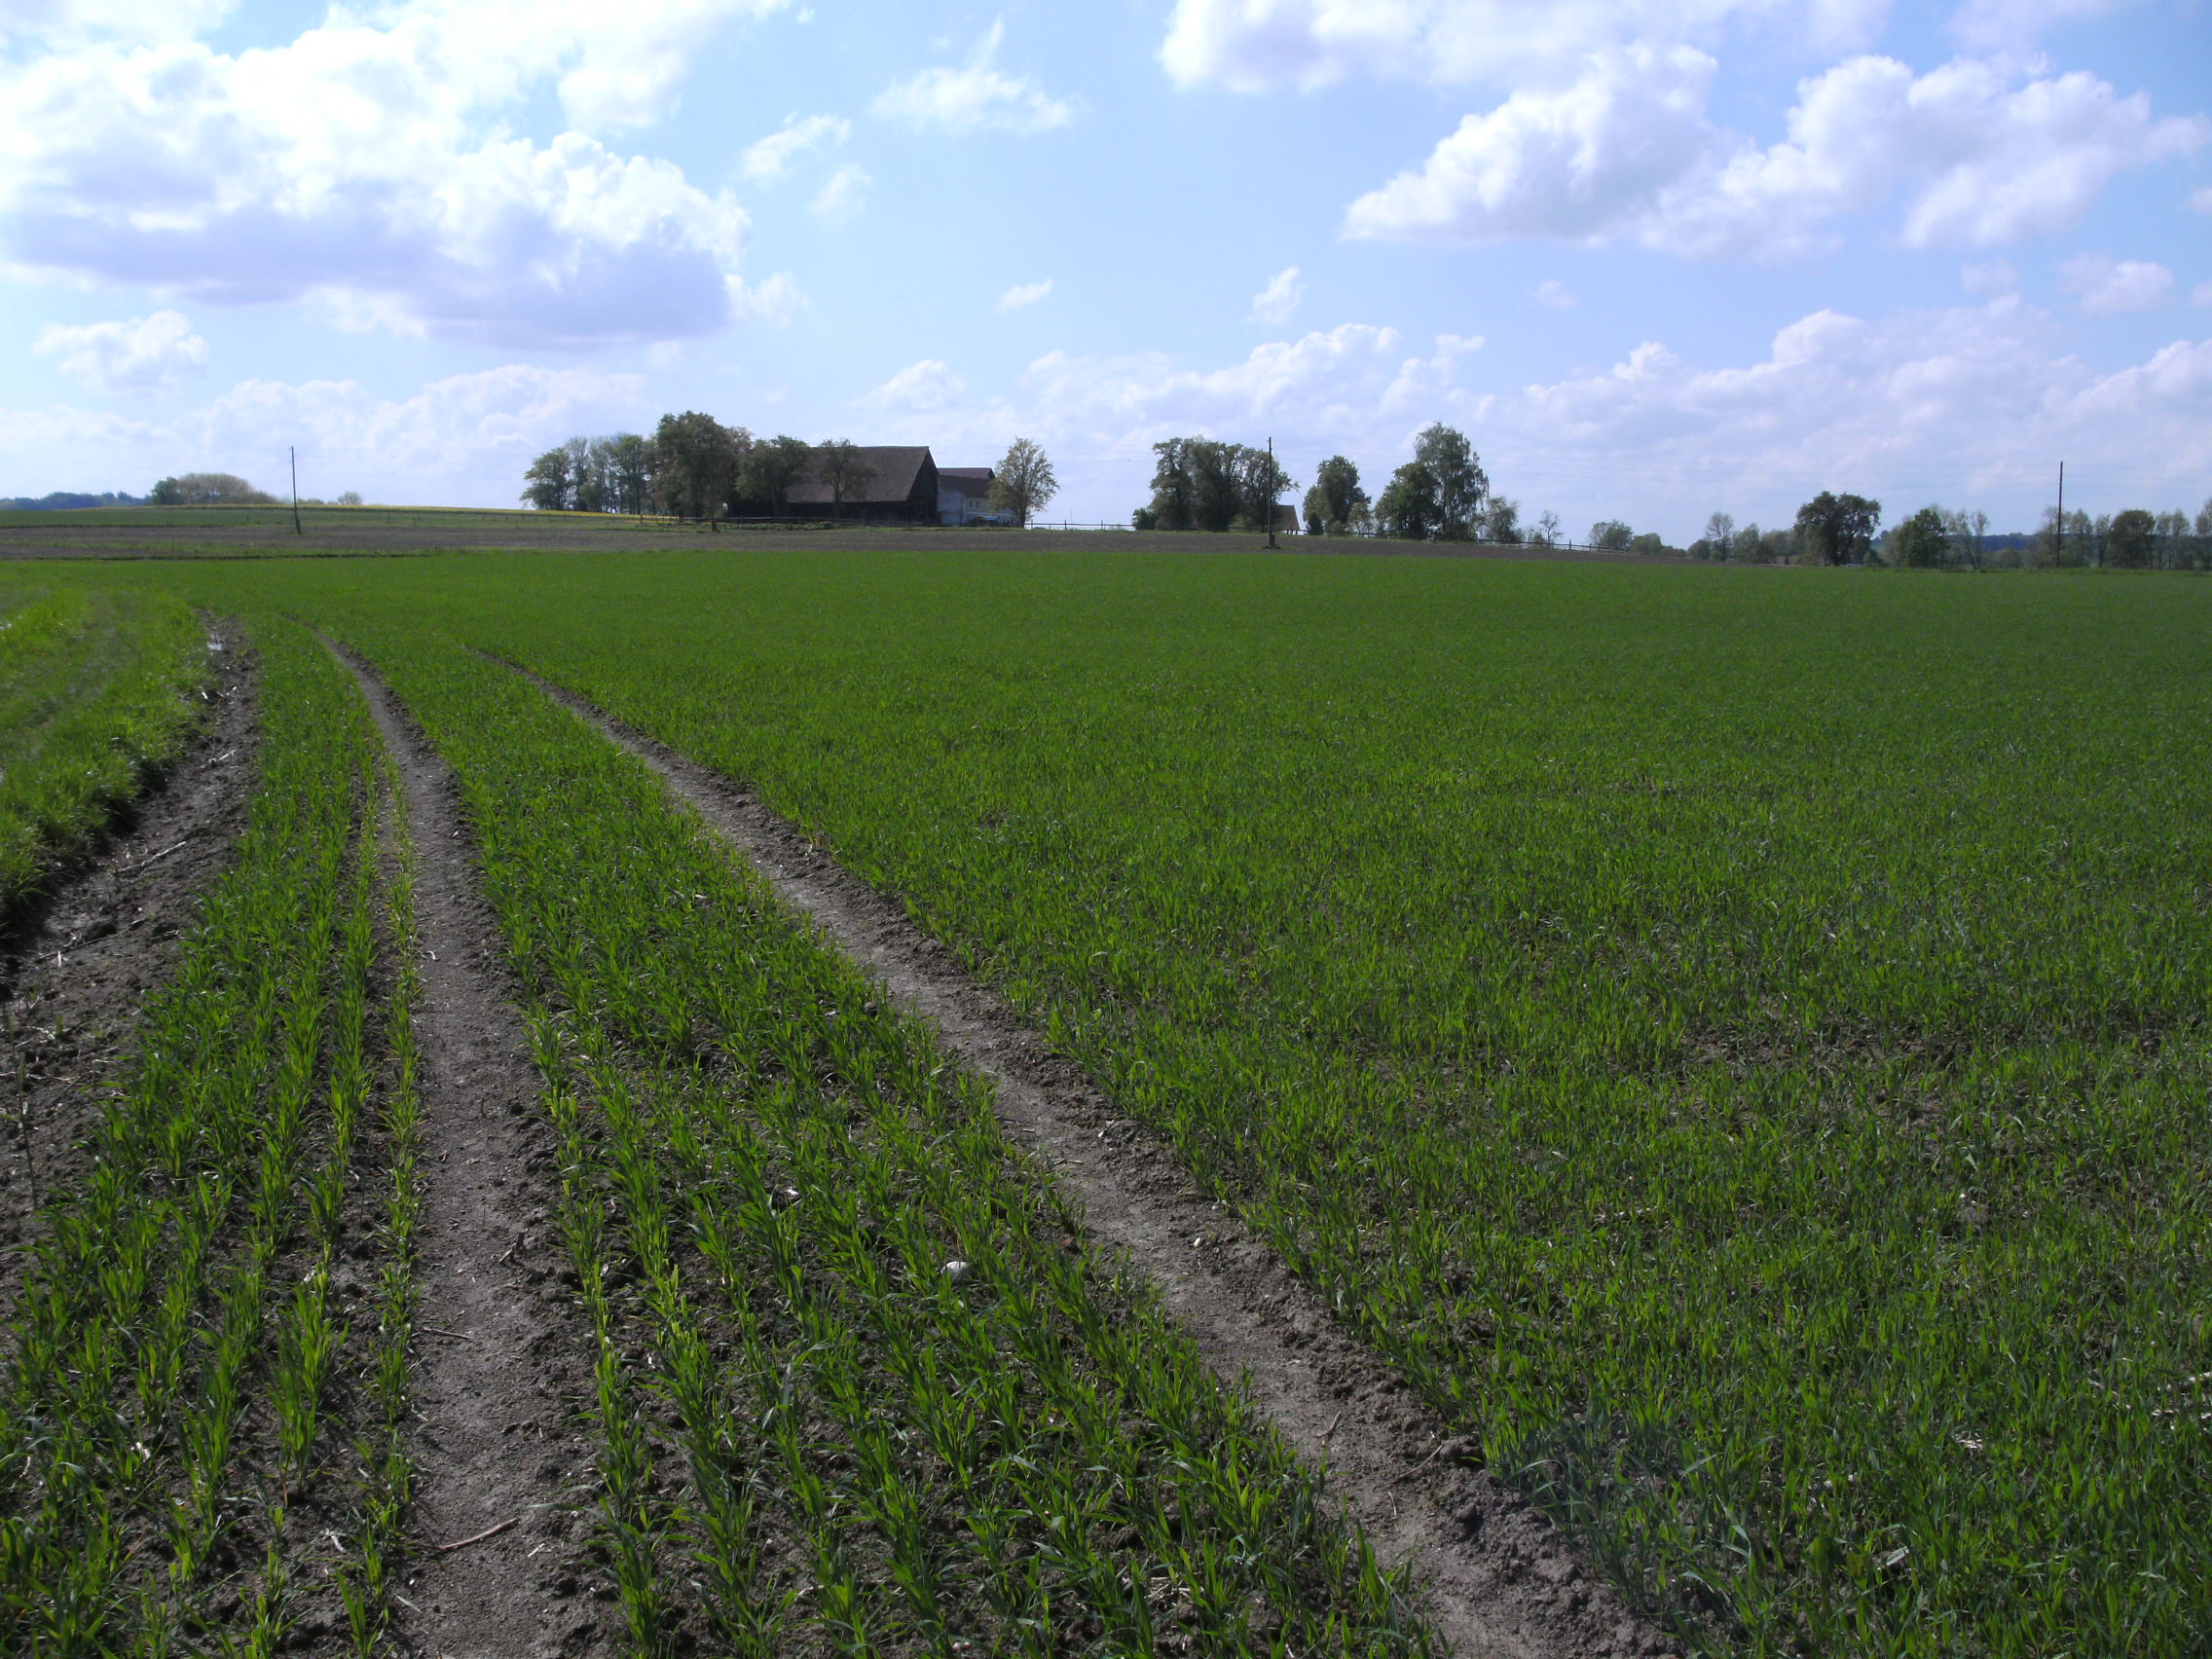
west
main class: Cropland
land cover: Oats
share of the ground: 50 - 75 %
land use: Agriculture (excluding fallow land and kitchen gardens)
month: May
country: AT
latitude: 48.2935
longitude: 13.5174
